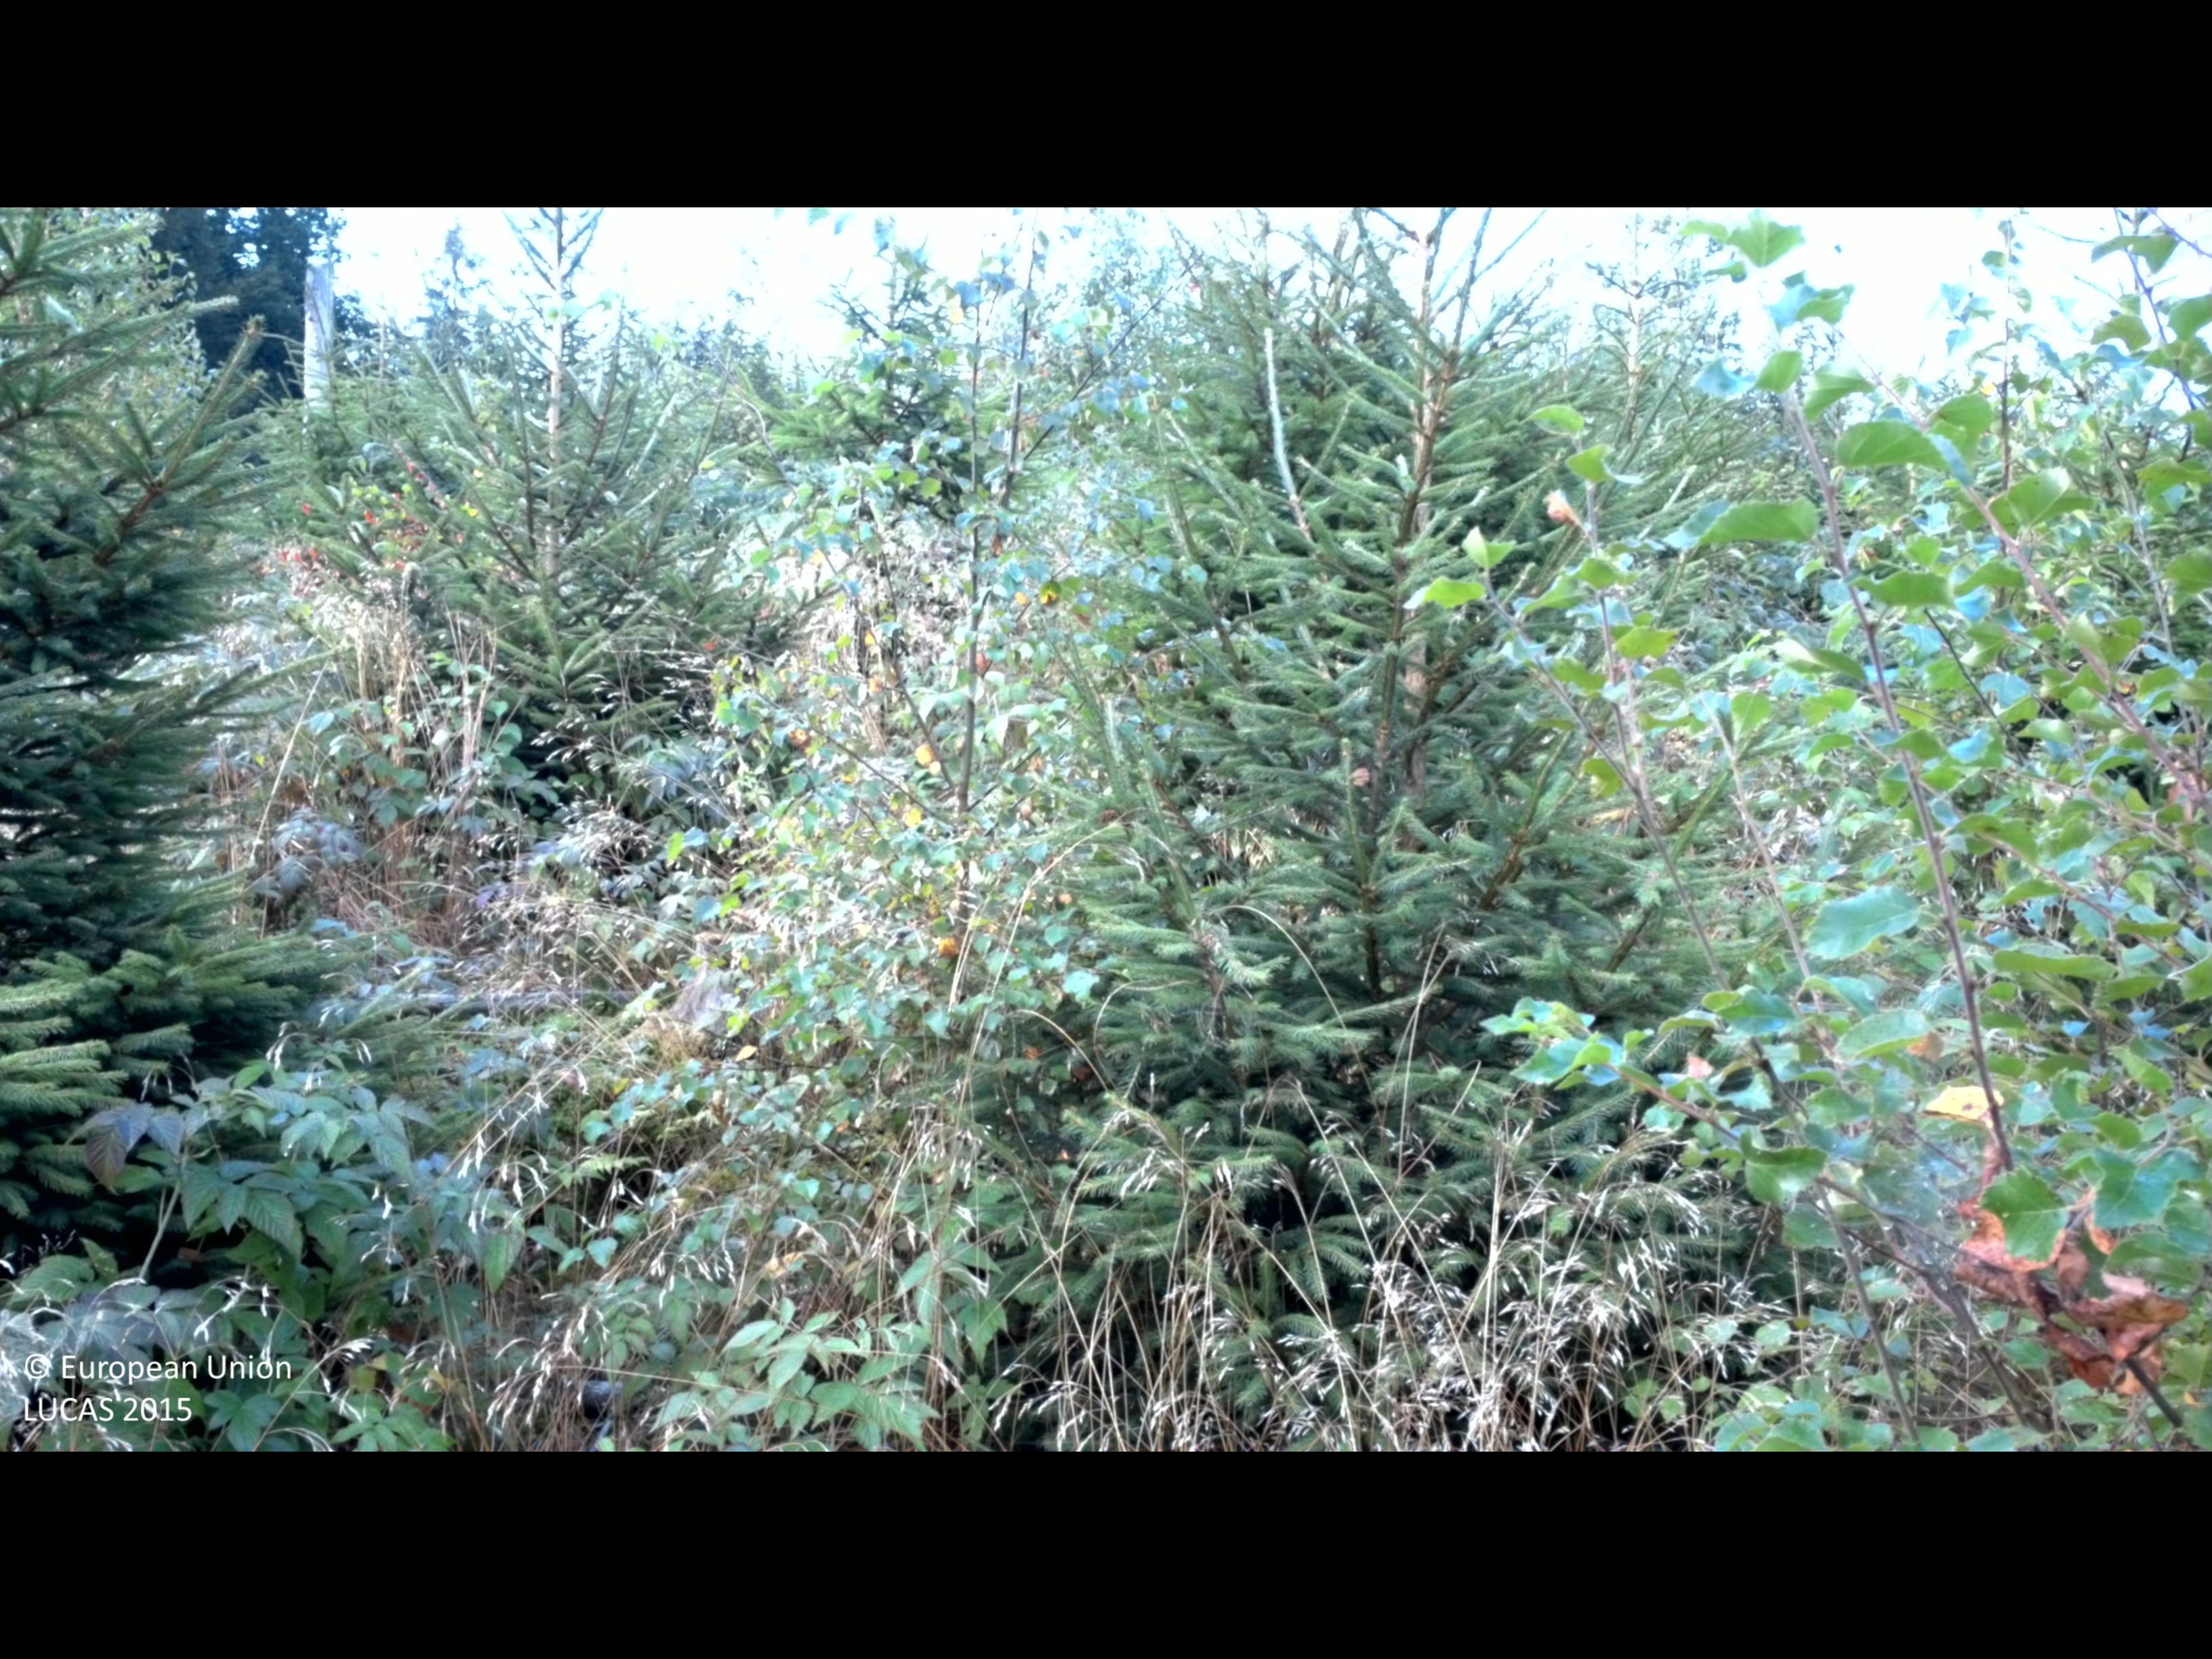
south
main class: Woodland
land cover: Spruce dominated mixed woodland
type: boreal forest
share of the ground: 50 - 75 %
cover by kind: coniferous forest trees 45 %, shrubs 30 %, broadleaved forest trees 15 %, herbaceous plants 10 %
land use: Forestry
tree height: < 5 m
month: August
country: SE
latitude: 56.7951
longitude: 13.2221
